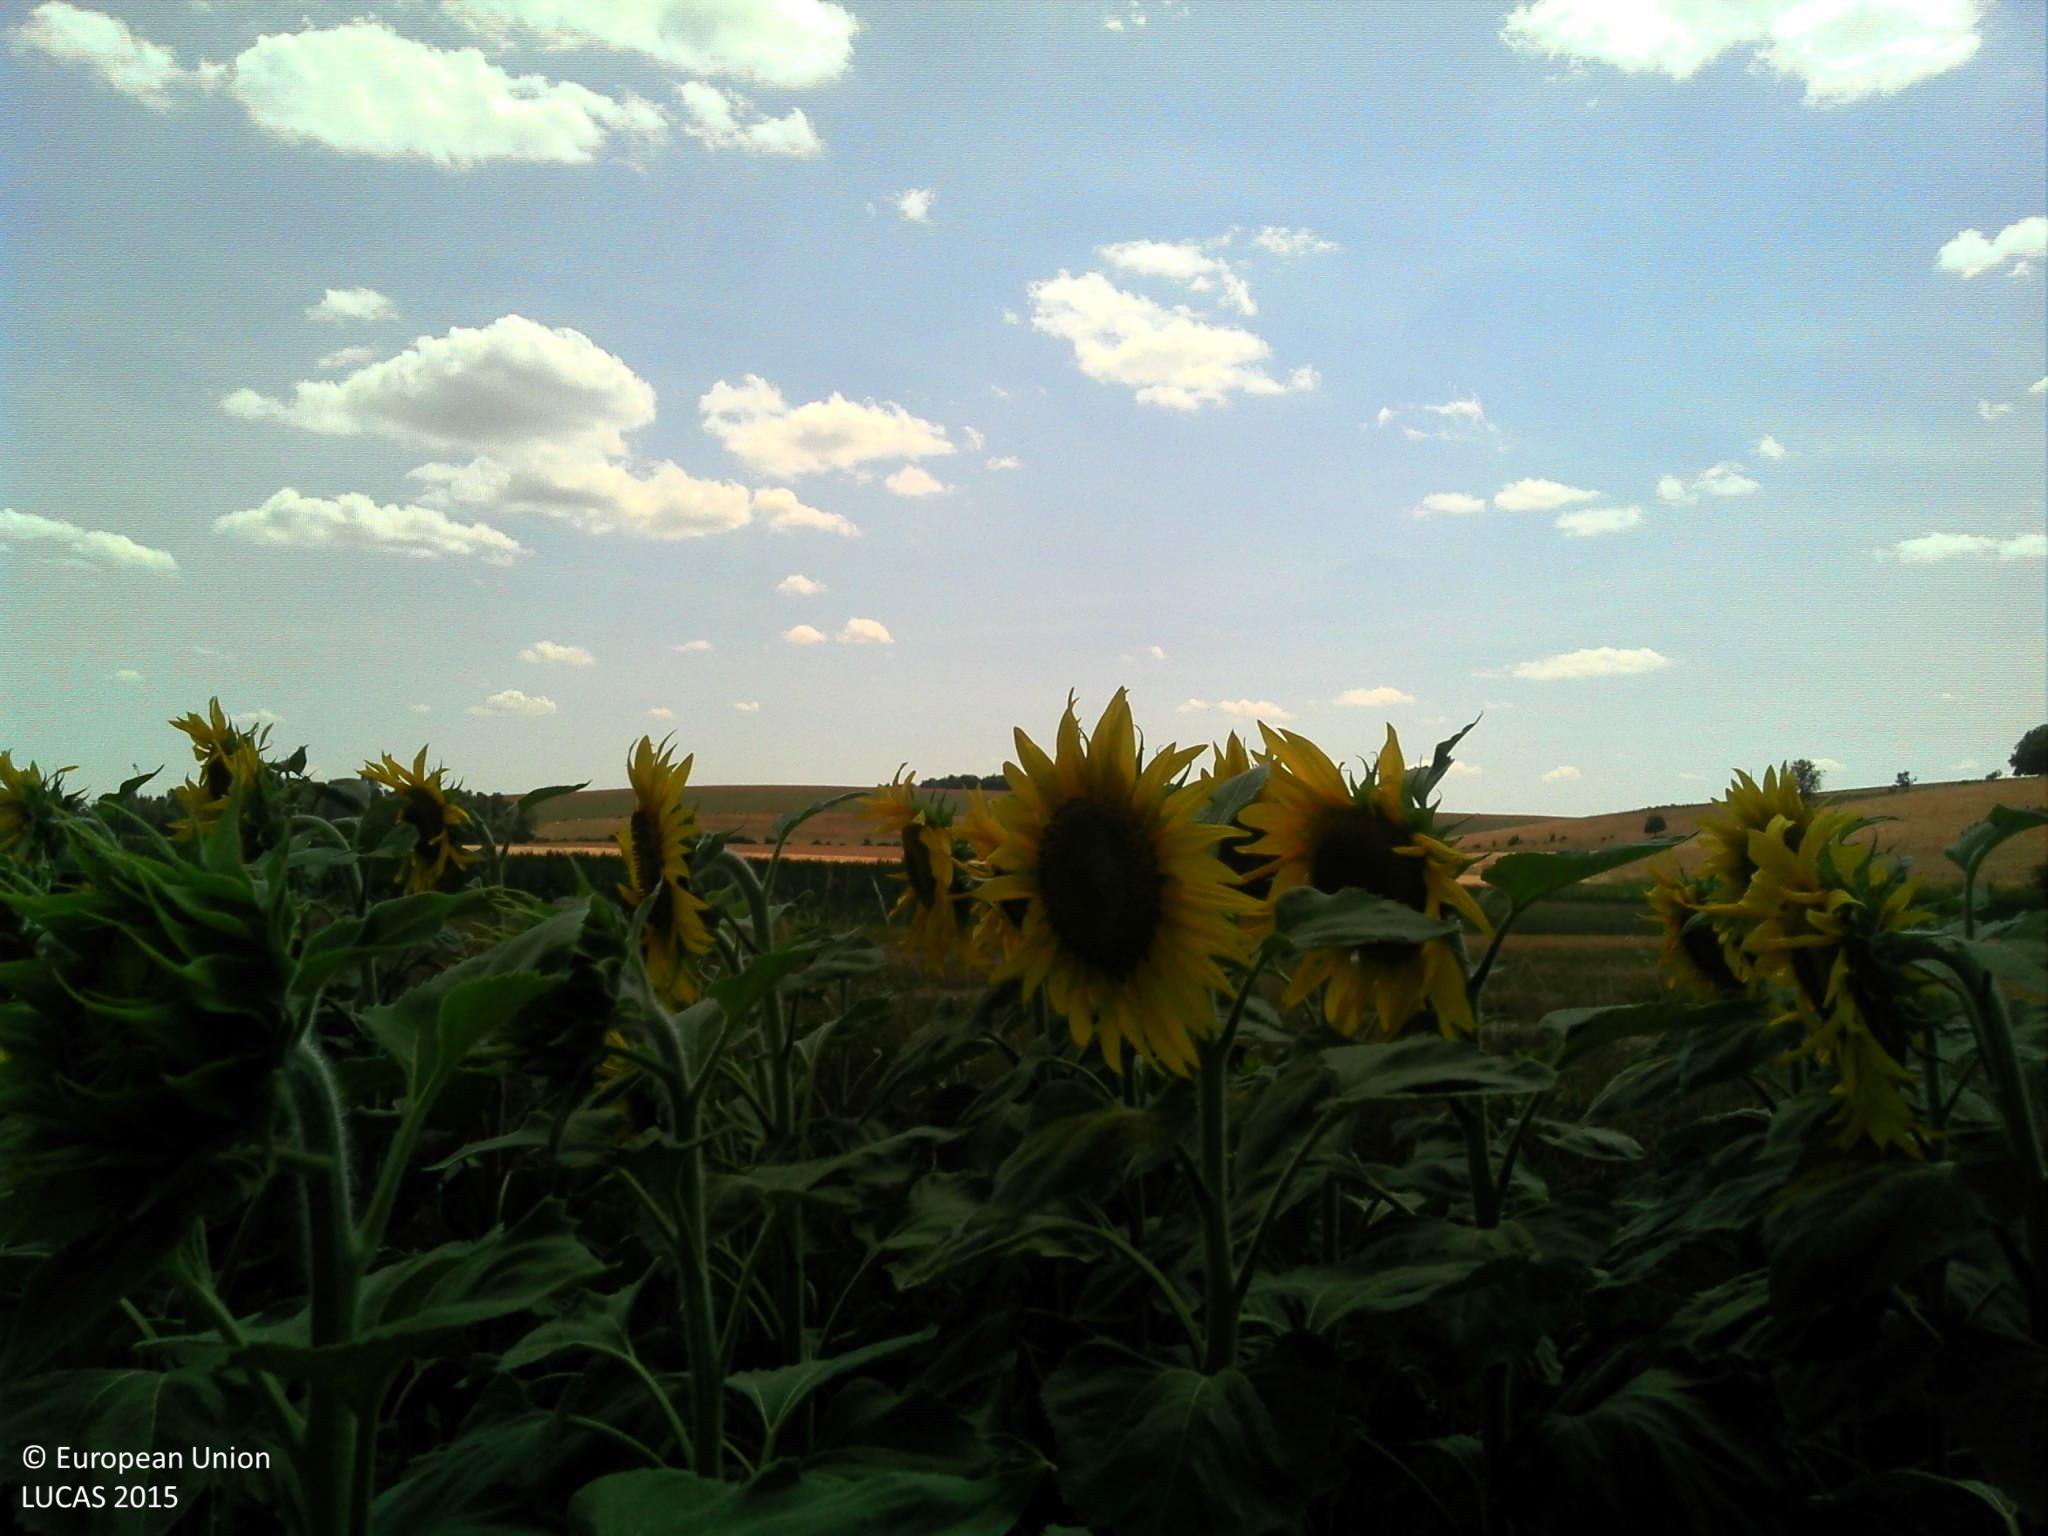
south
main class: Cropland
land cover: Sunflower
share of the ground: > 75 %
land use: Agriculture (excluding fallow land and kitchen gardens)
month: July
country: FR
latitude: 48.1047
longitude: 4.8820
